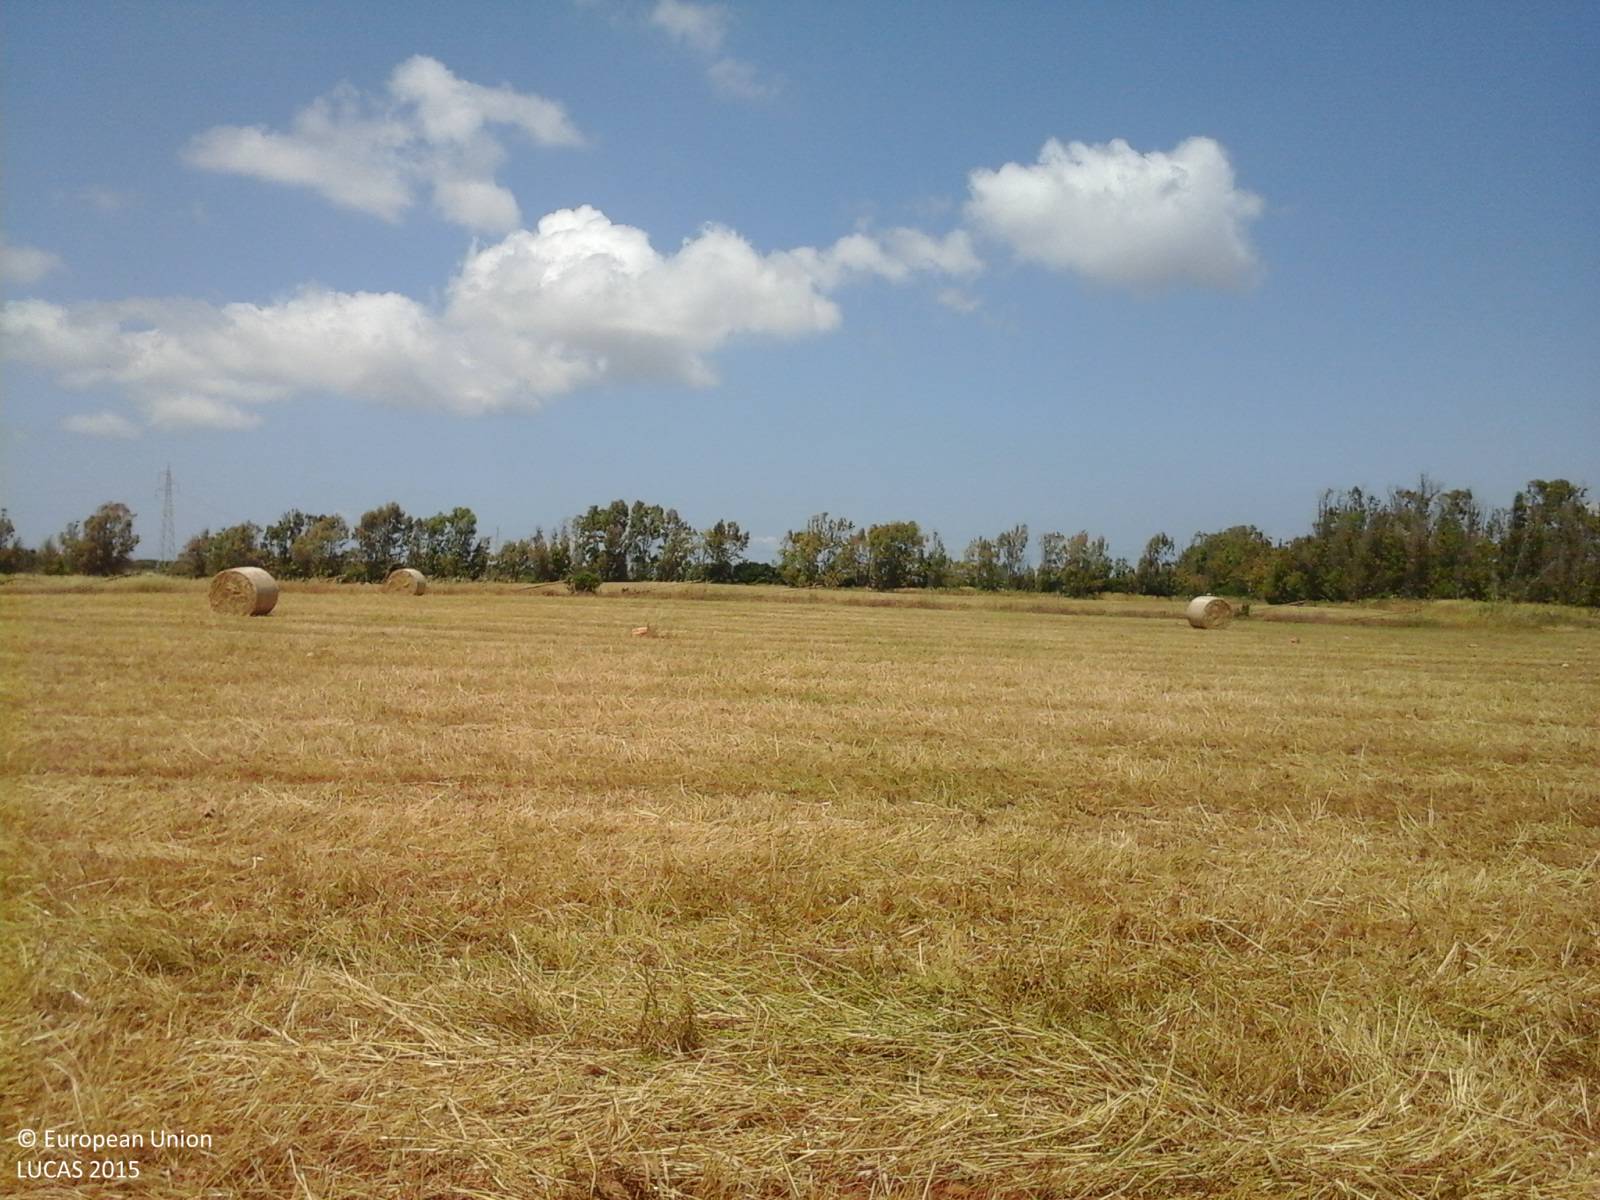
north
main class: Grassland
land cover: Grassland without tree/shrub cover
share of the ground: > 75 %
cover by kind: herbaceous plants 100 %
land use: Agriculture (excluding fallow land and kitchen gardens)
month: May
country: IT
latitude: 40.7605
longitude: 8.3613
